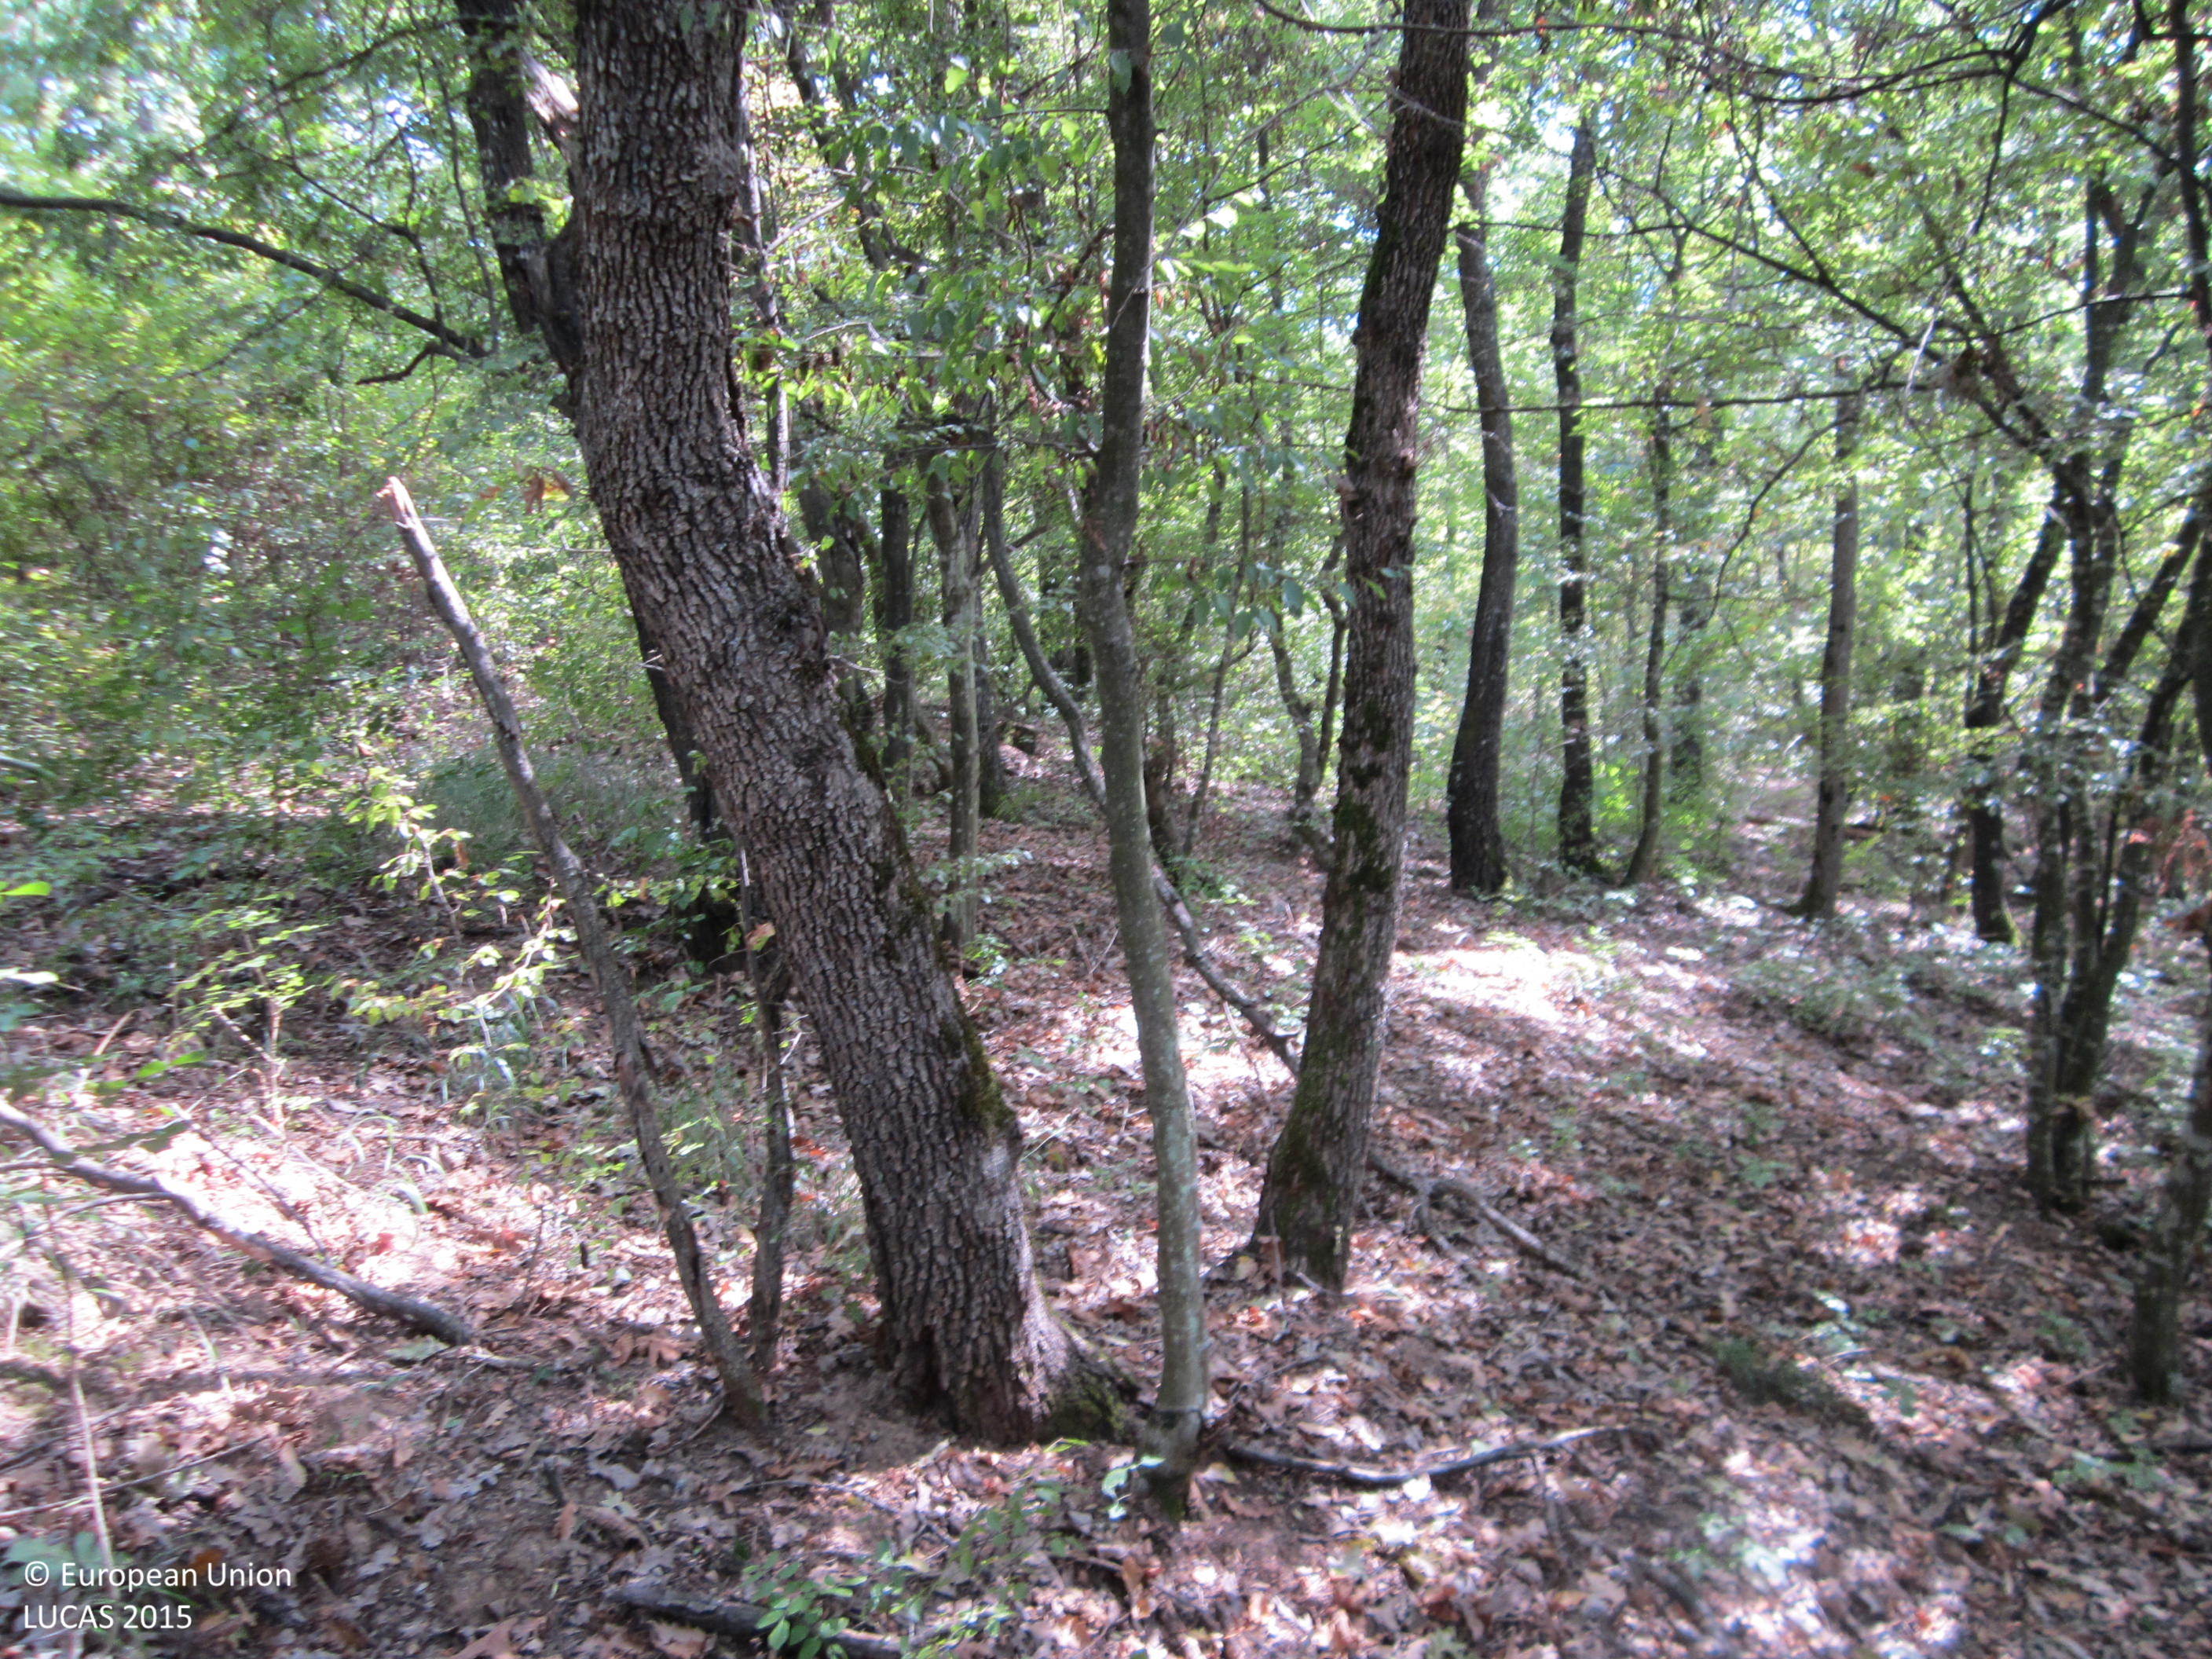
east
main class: Woodland
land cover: Broadleaved woodland
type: mesophytic deciduous forest
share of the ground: > 75 %
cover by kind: broadleaved forest trees 90 %, shrubs 5 %, unconsolidated bare surface 5 %
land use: Forestry
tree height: > 5 m
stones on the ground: < 10 %
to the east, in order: Broadleaved woodland; Rivers and streams; Broadleaved woodland; Shruby margins; Sunflower
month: September
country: BG
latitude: 42.8042
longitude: 27.1209
